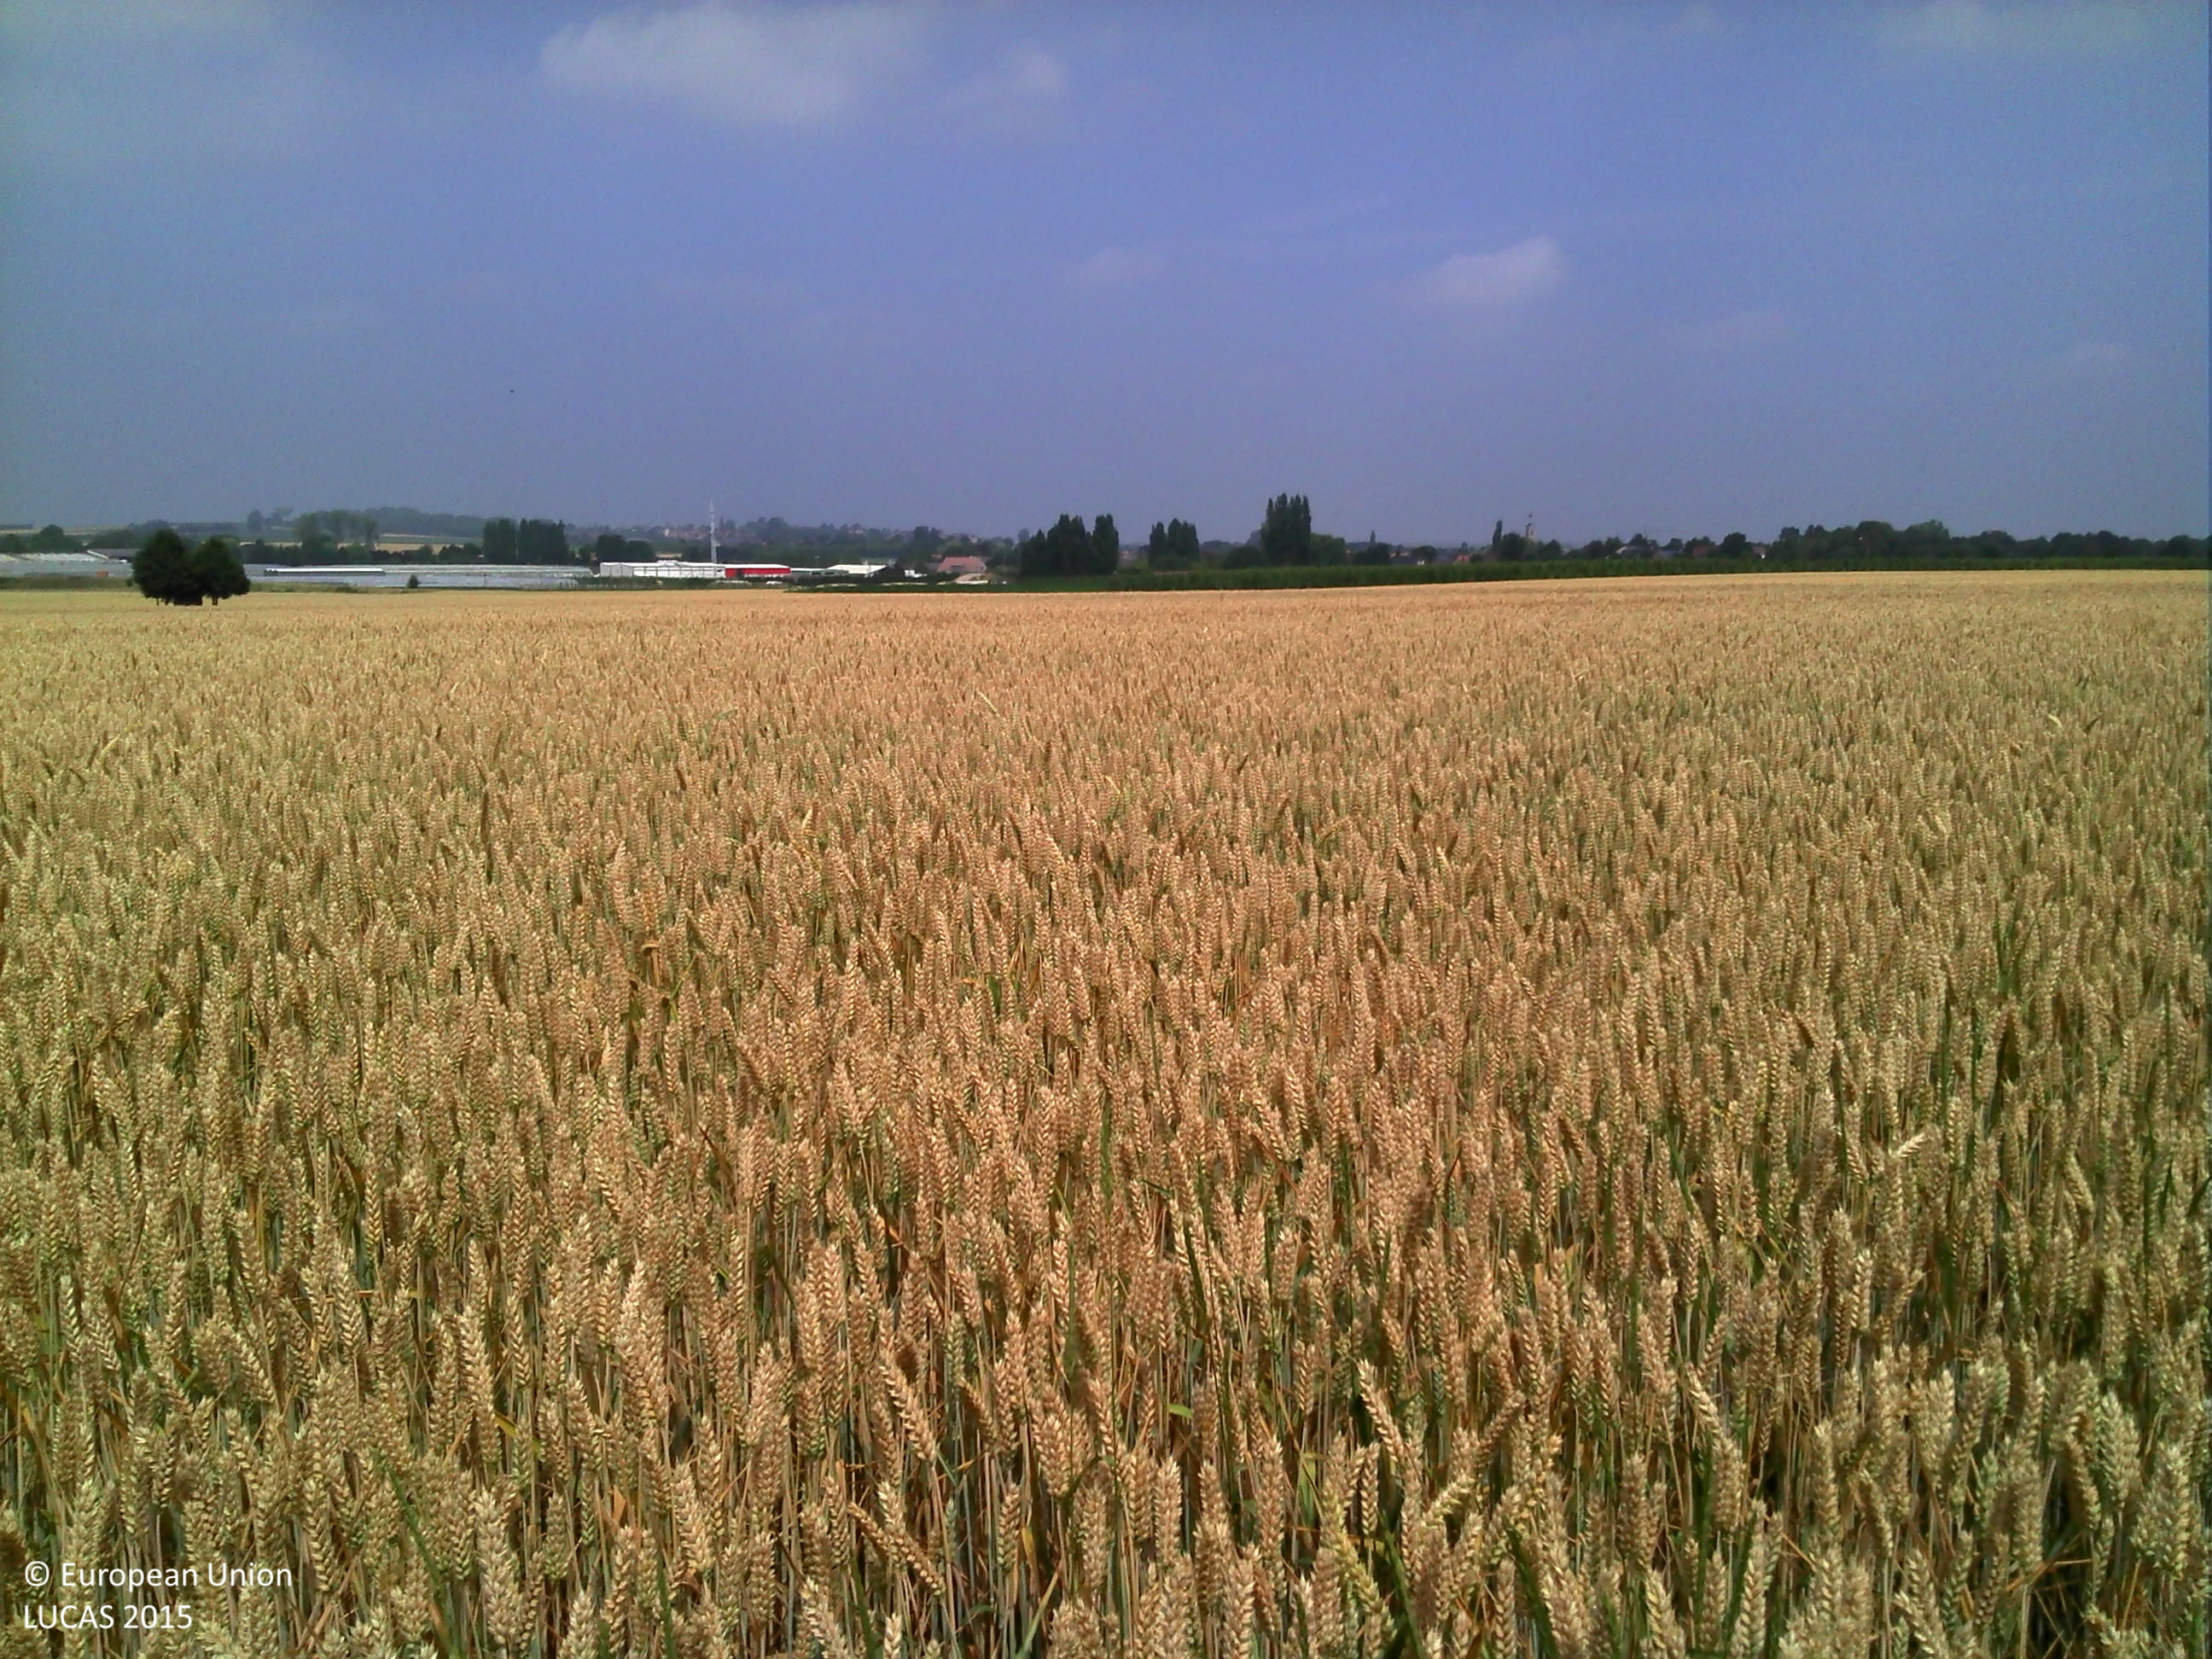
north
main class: Cropland
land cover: Common wheat
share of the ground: > 75 %
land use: Agriculture (excluding fallow land and kitchen gardens)
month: July
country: BE
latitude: 50.8190
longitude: 5.5838
